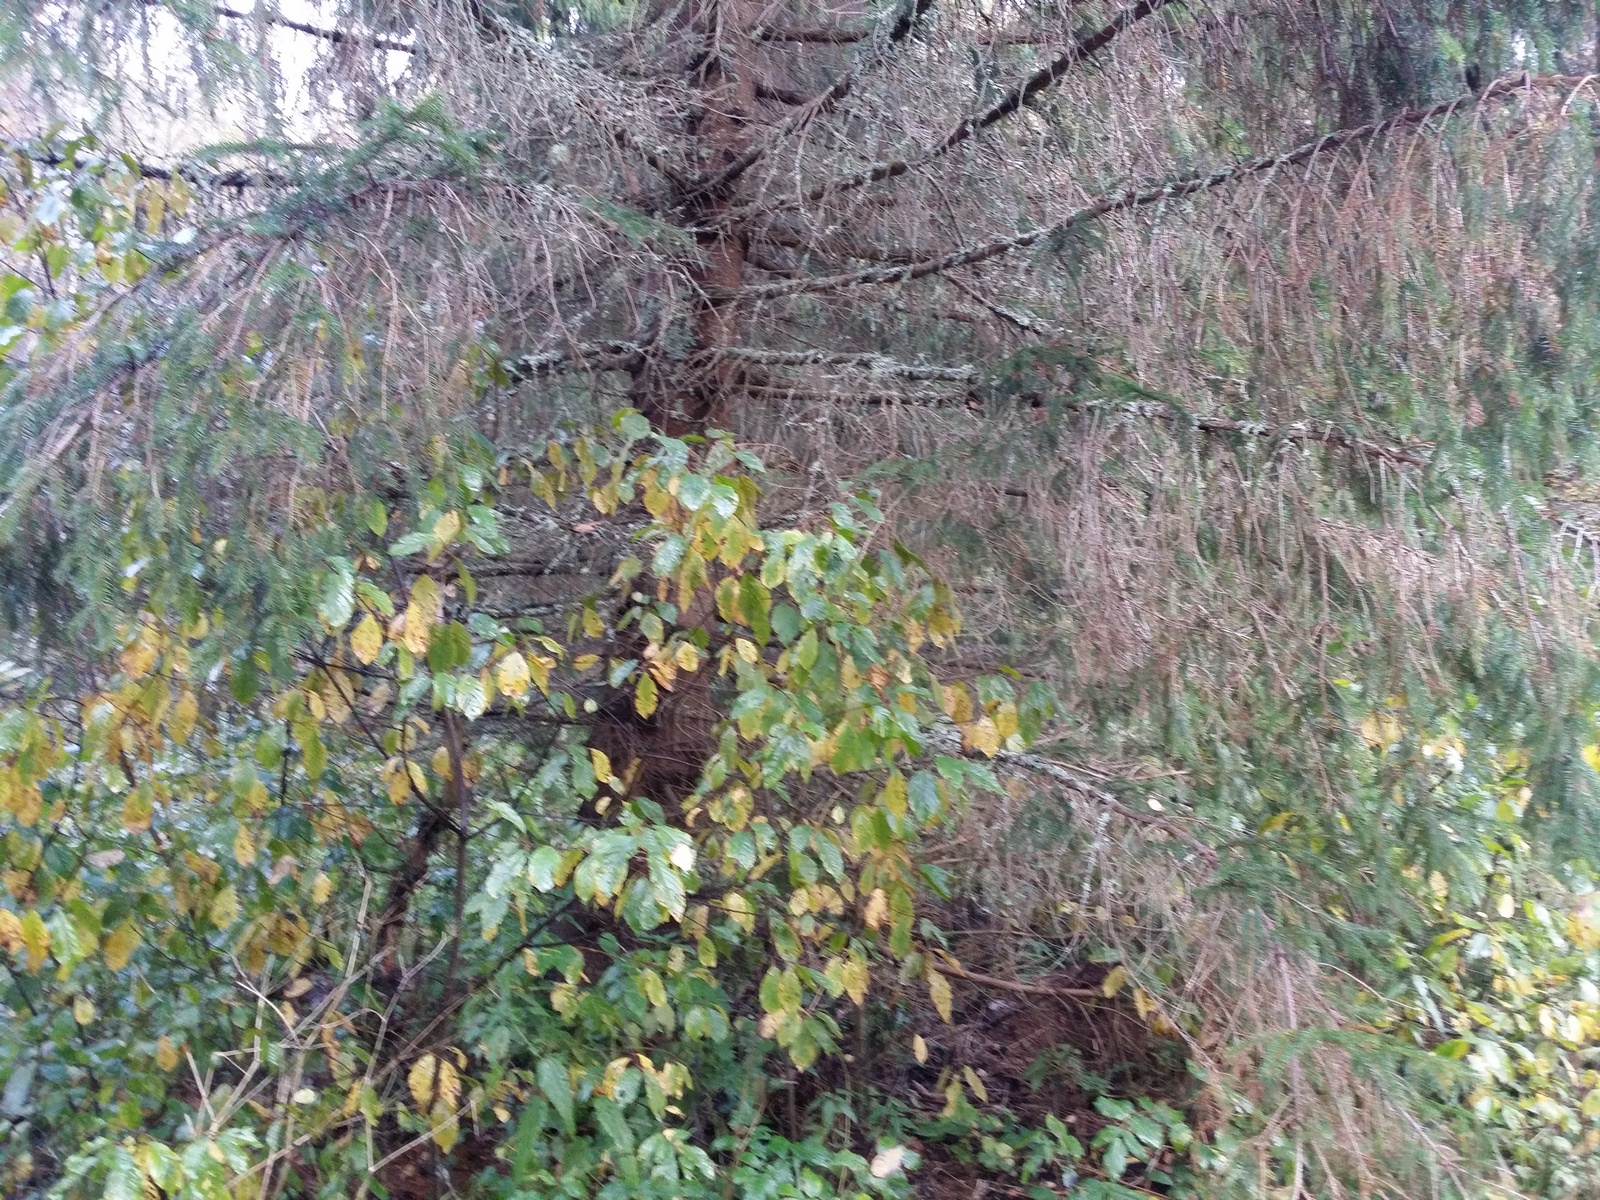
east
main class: Woodland
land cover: Spruce dominated mixed woodland
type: hemiboreal forest and nemoral coniferous forest and mixed broadleaved-coniferous forest
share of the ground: 50 - 75 %
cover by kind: coniferous forest trees 40 %, broadleaved forest trees 25 %, shrubs 15 %, herbaceous plants 10 %, lichens and mosses 10 %
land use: Forestry
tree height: > 5 m
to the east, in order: Spruce dominated mixed woodland; Broadleaved woodland; Ditches and canals; Abandoned hedges; Common wheat
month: September
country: LV
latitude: 57.4944
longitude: 27.4061
